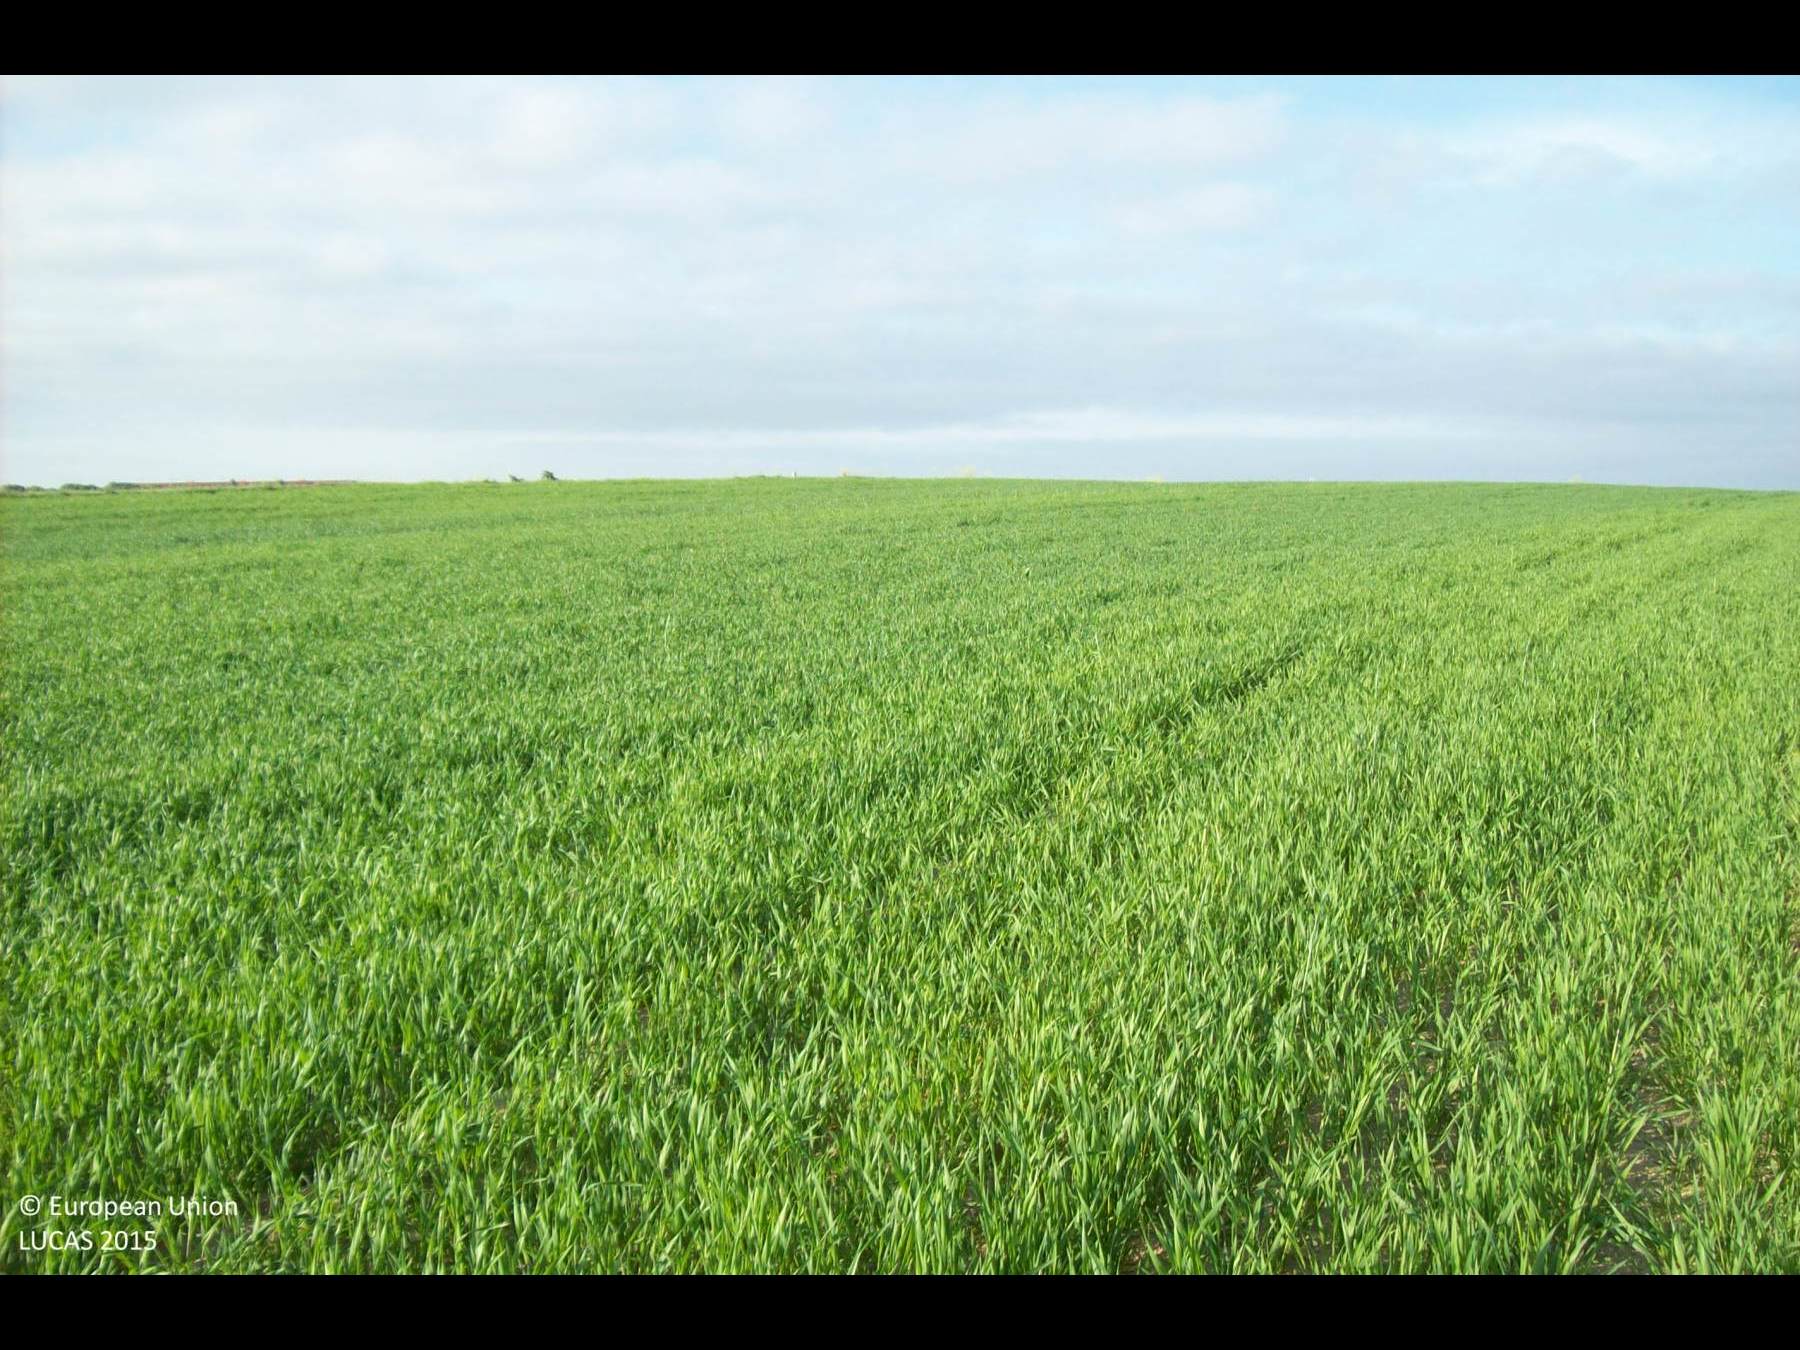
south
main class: Cropland
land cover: Barley
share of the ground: > 75 %
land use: Agriculture (excluding fallow land and kitchen gardens)
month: April
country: ES
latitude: 40.3186
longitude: -3.8899
